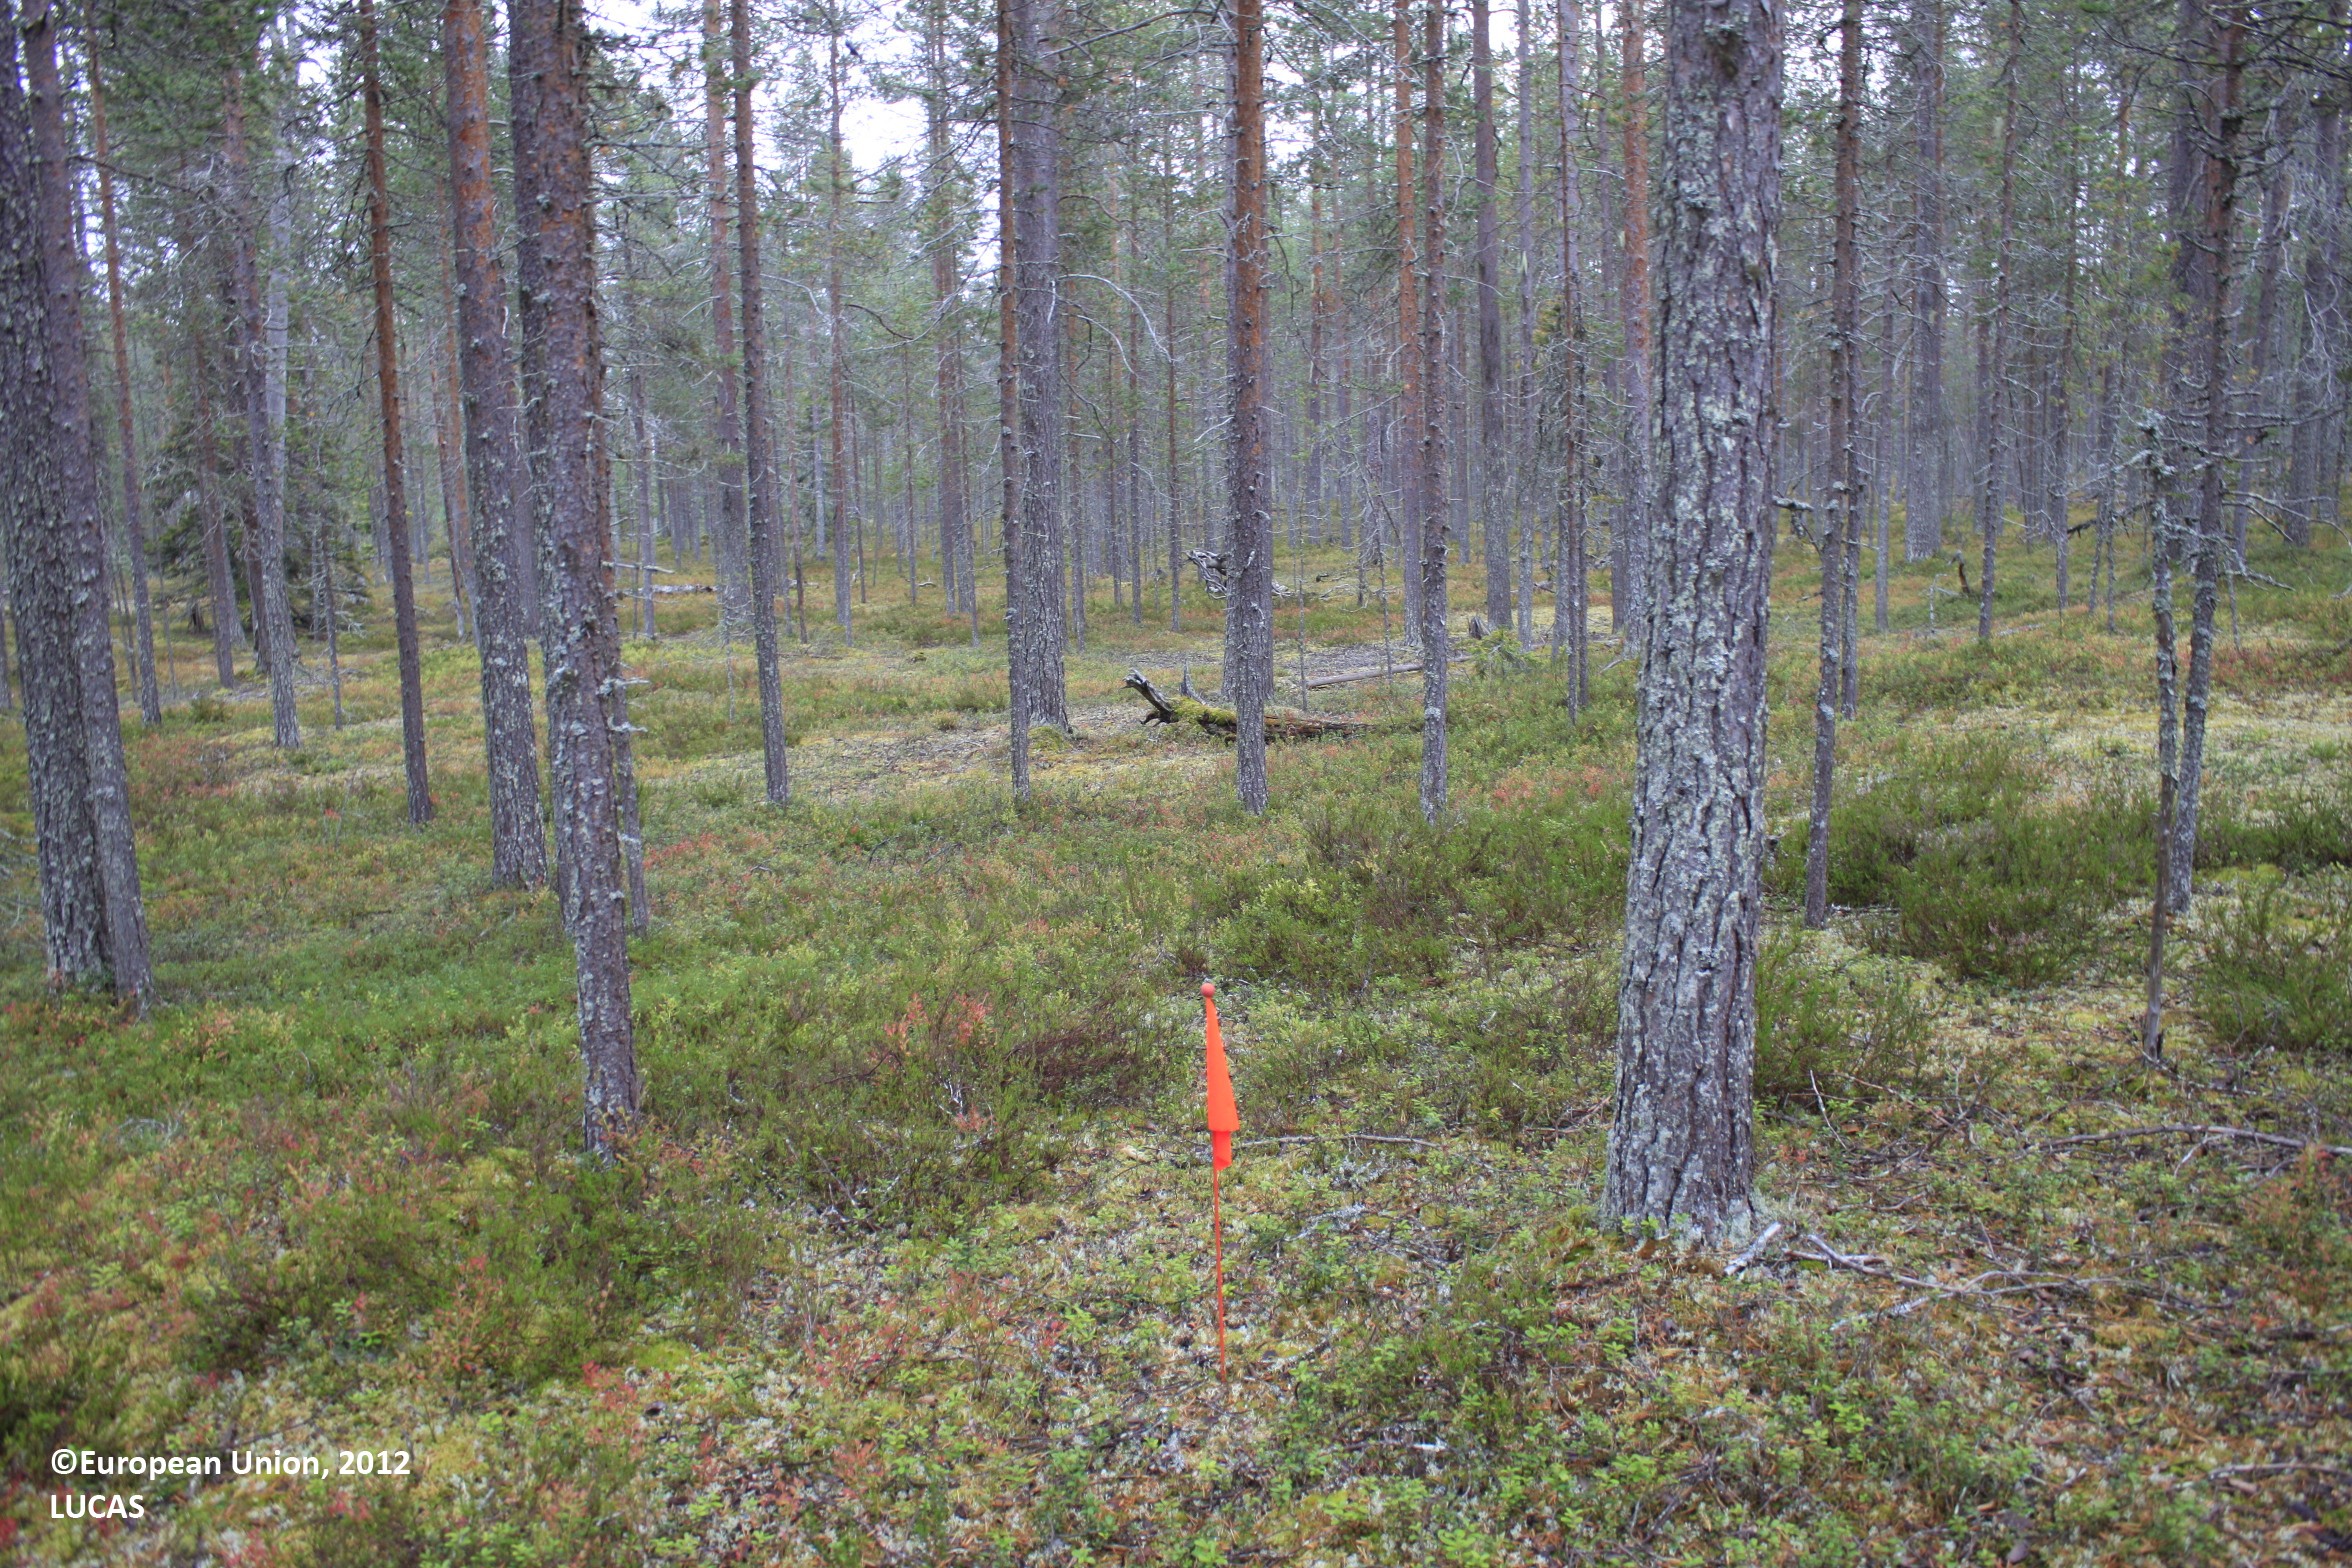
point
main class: Woodland
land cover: Pine dominated coniferous woodland
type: boreal forest
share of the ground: 50 - 75 %
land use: Forestry
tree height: > 5 m
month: September
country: FI
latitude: 65.5409
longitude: 27.1087
